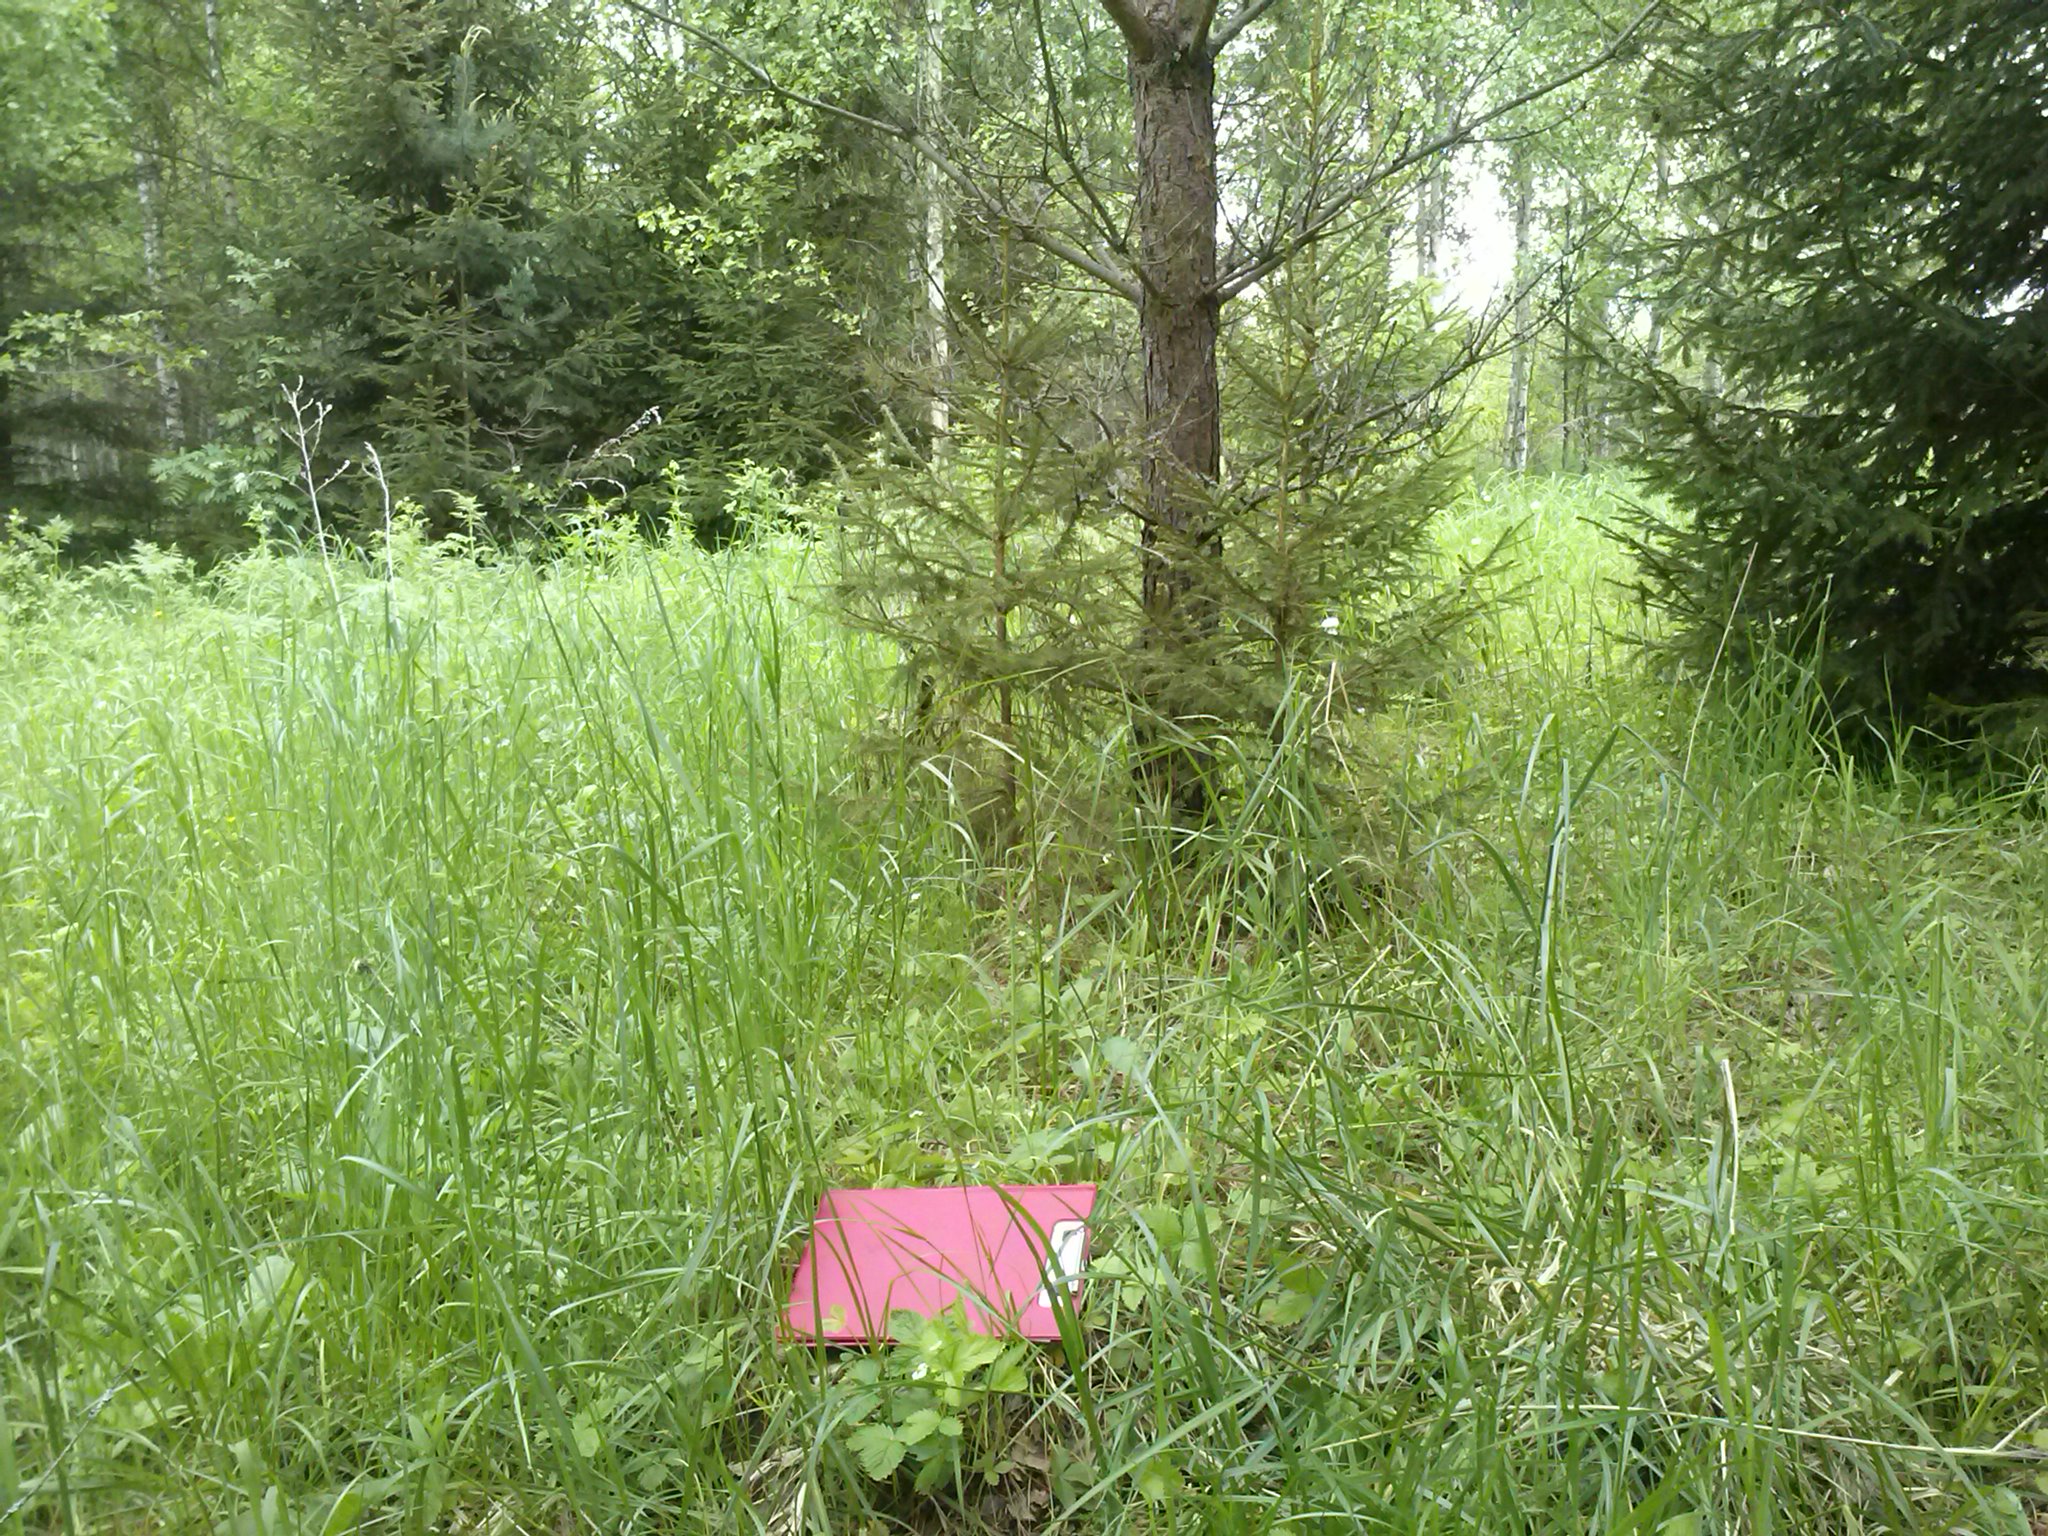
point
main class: Woodland
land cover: Other mixed woodland
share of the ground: > 75 %
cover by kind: coniferous forest trees 45 %, broadleaved forest trees 30 %, herbaceous plants 25 %
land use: Forestry
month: May
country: LV
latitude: 56.1923
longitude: 27.7380
